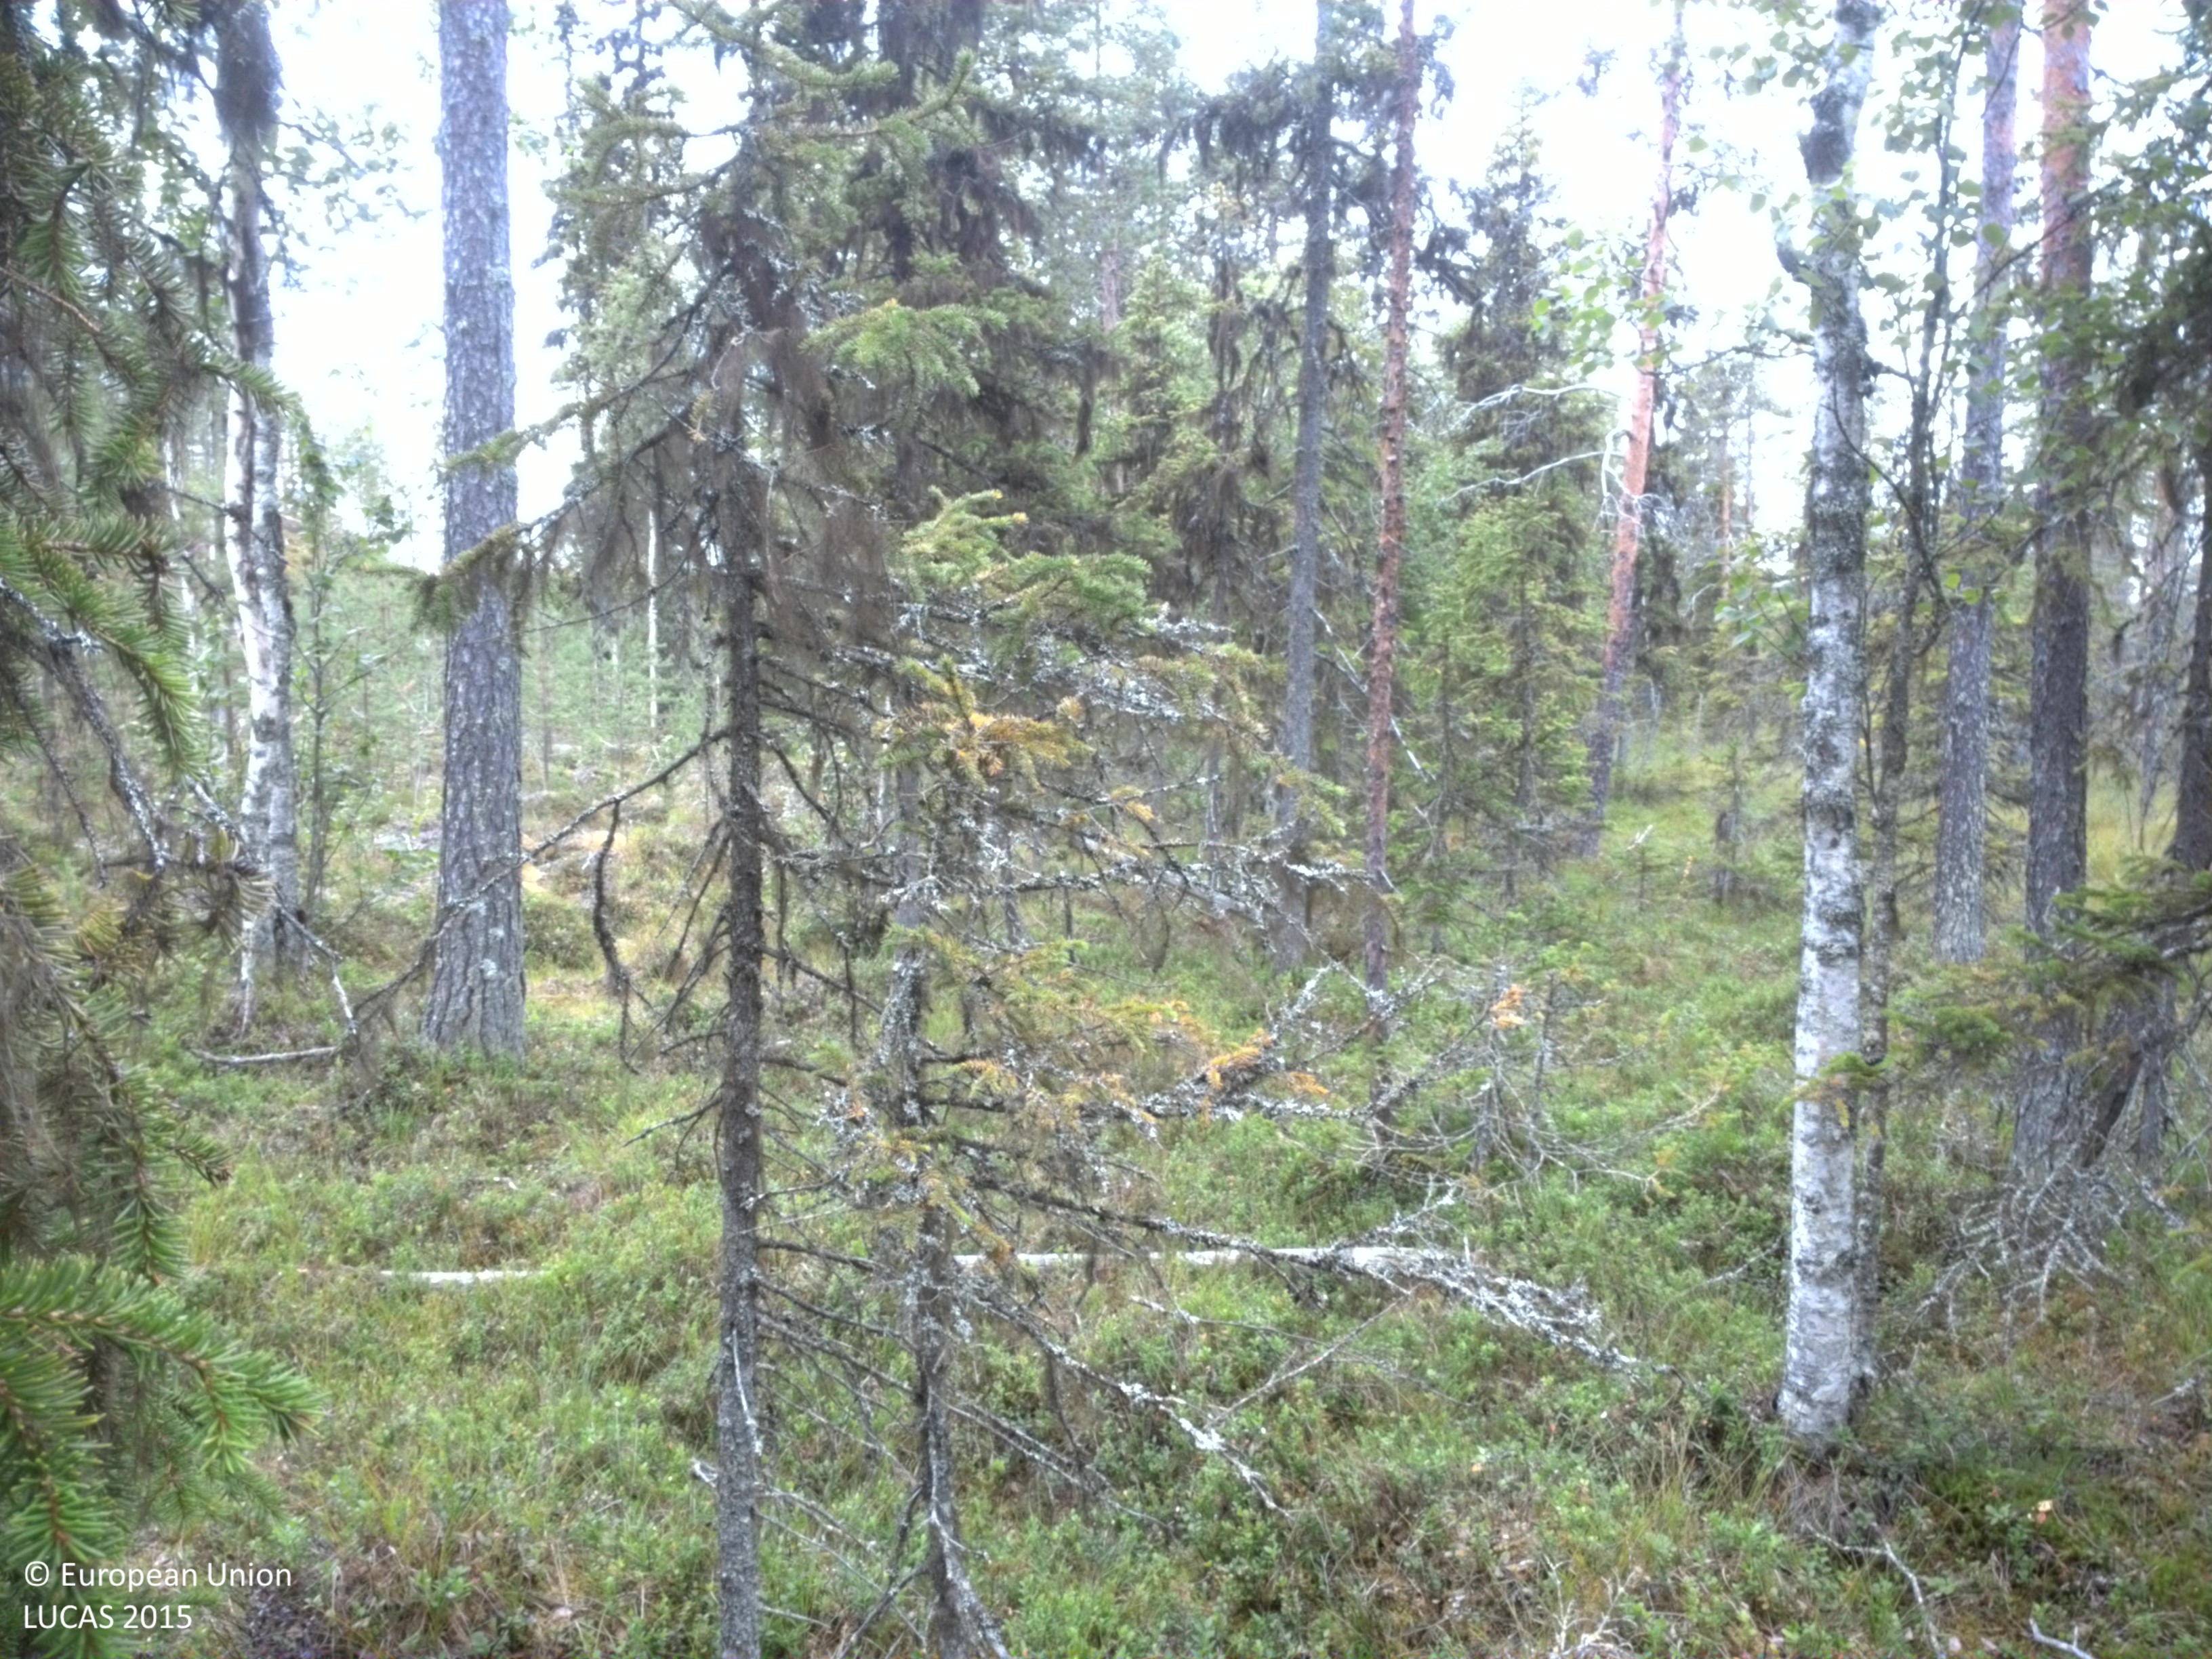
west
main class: Woodland
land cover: Spruce dominated coniferous woodland
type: boreal forest
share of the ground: 50 - 75 %
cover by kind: coniferous forest trees 50 %, shrubs 30 %, herbaceous plants 10 %, lichens and mosses 10 %
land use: Forestry
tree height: > 5 m
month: August
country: SE
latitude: 64.5937
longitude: 19.9794
